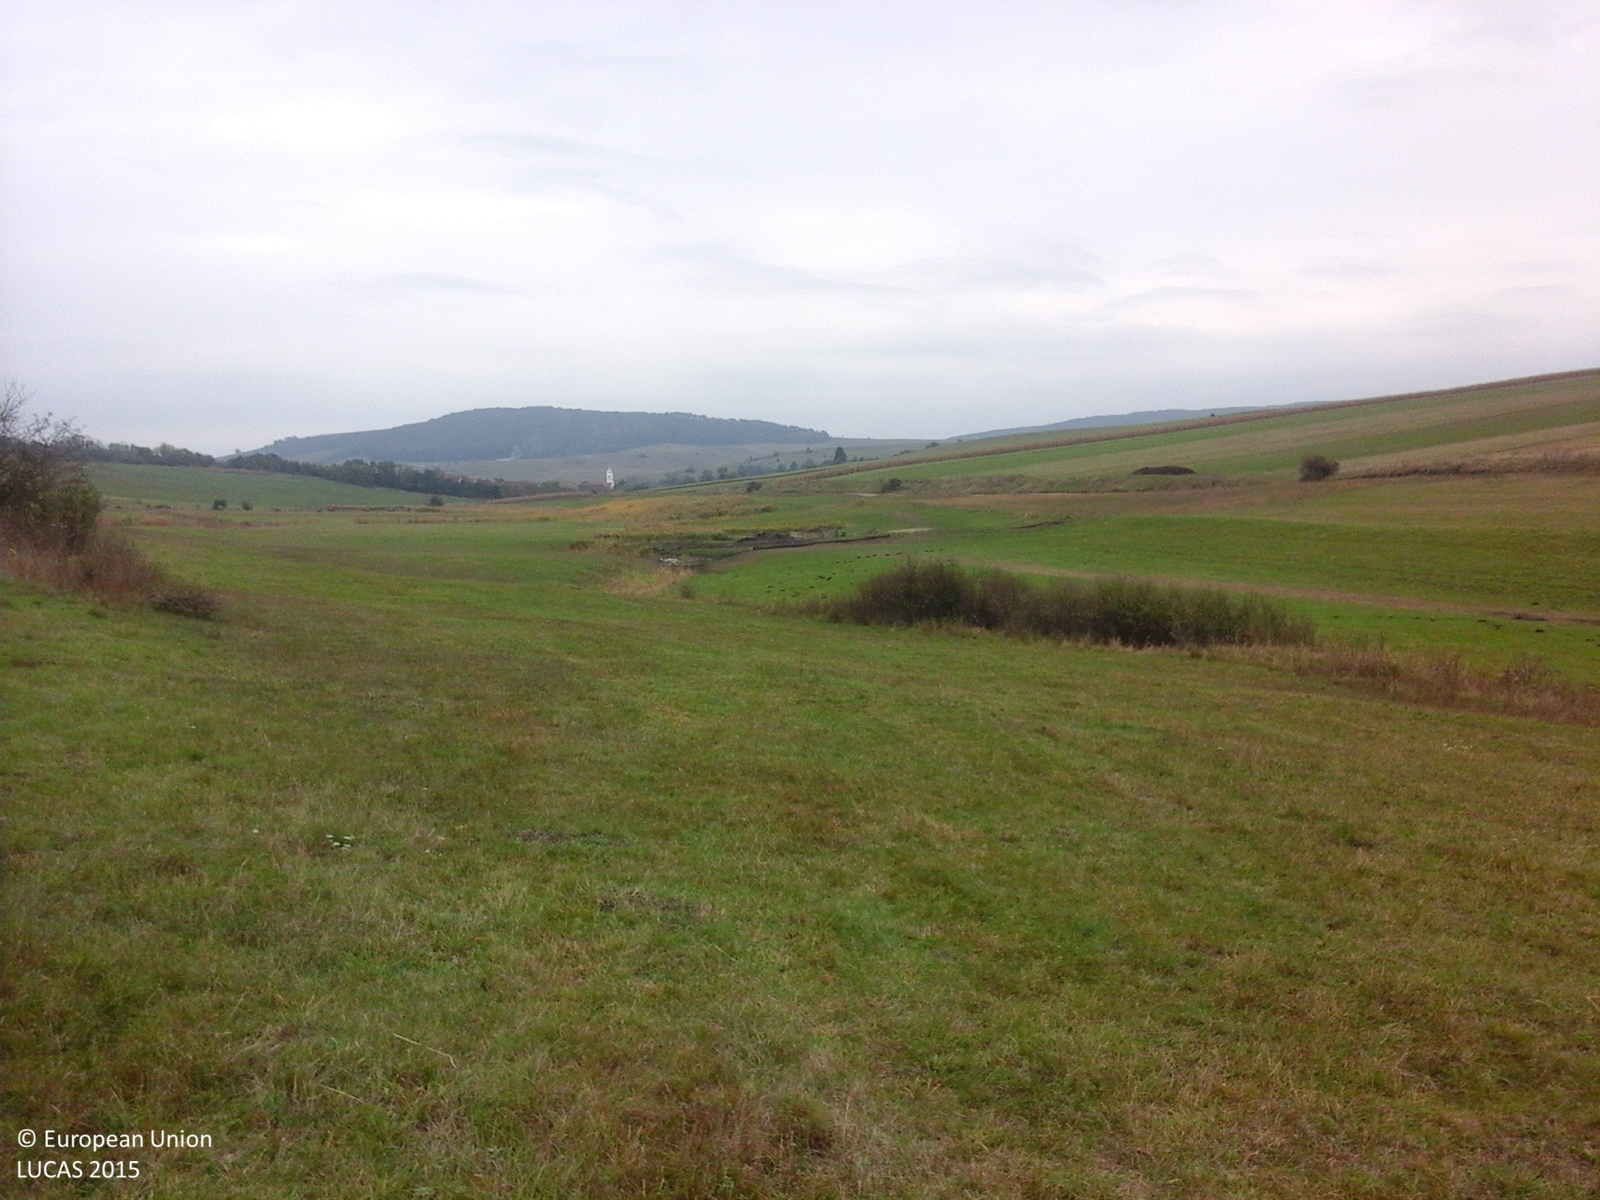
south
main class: Grassland
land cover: Grassland without tree/shrub cover
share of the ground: > 75 %
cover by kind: herbaceous plants 100 %
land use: Agriculture (excluding fallow land and kitchen gardens)
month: October
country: RO
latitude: 46.1317
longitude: 25.2304
